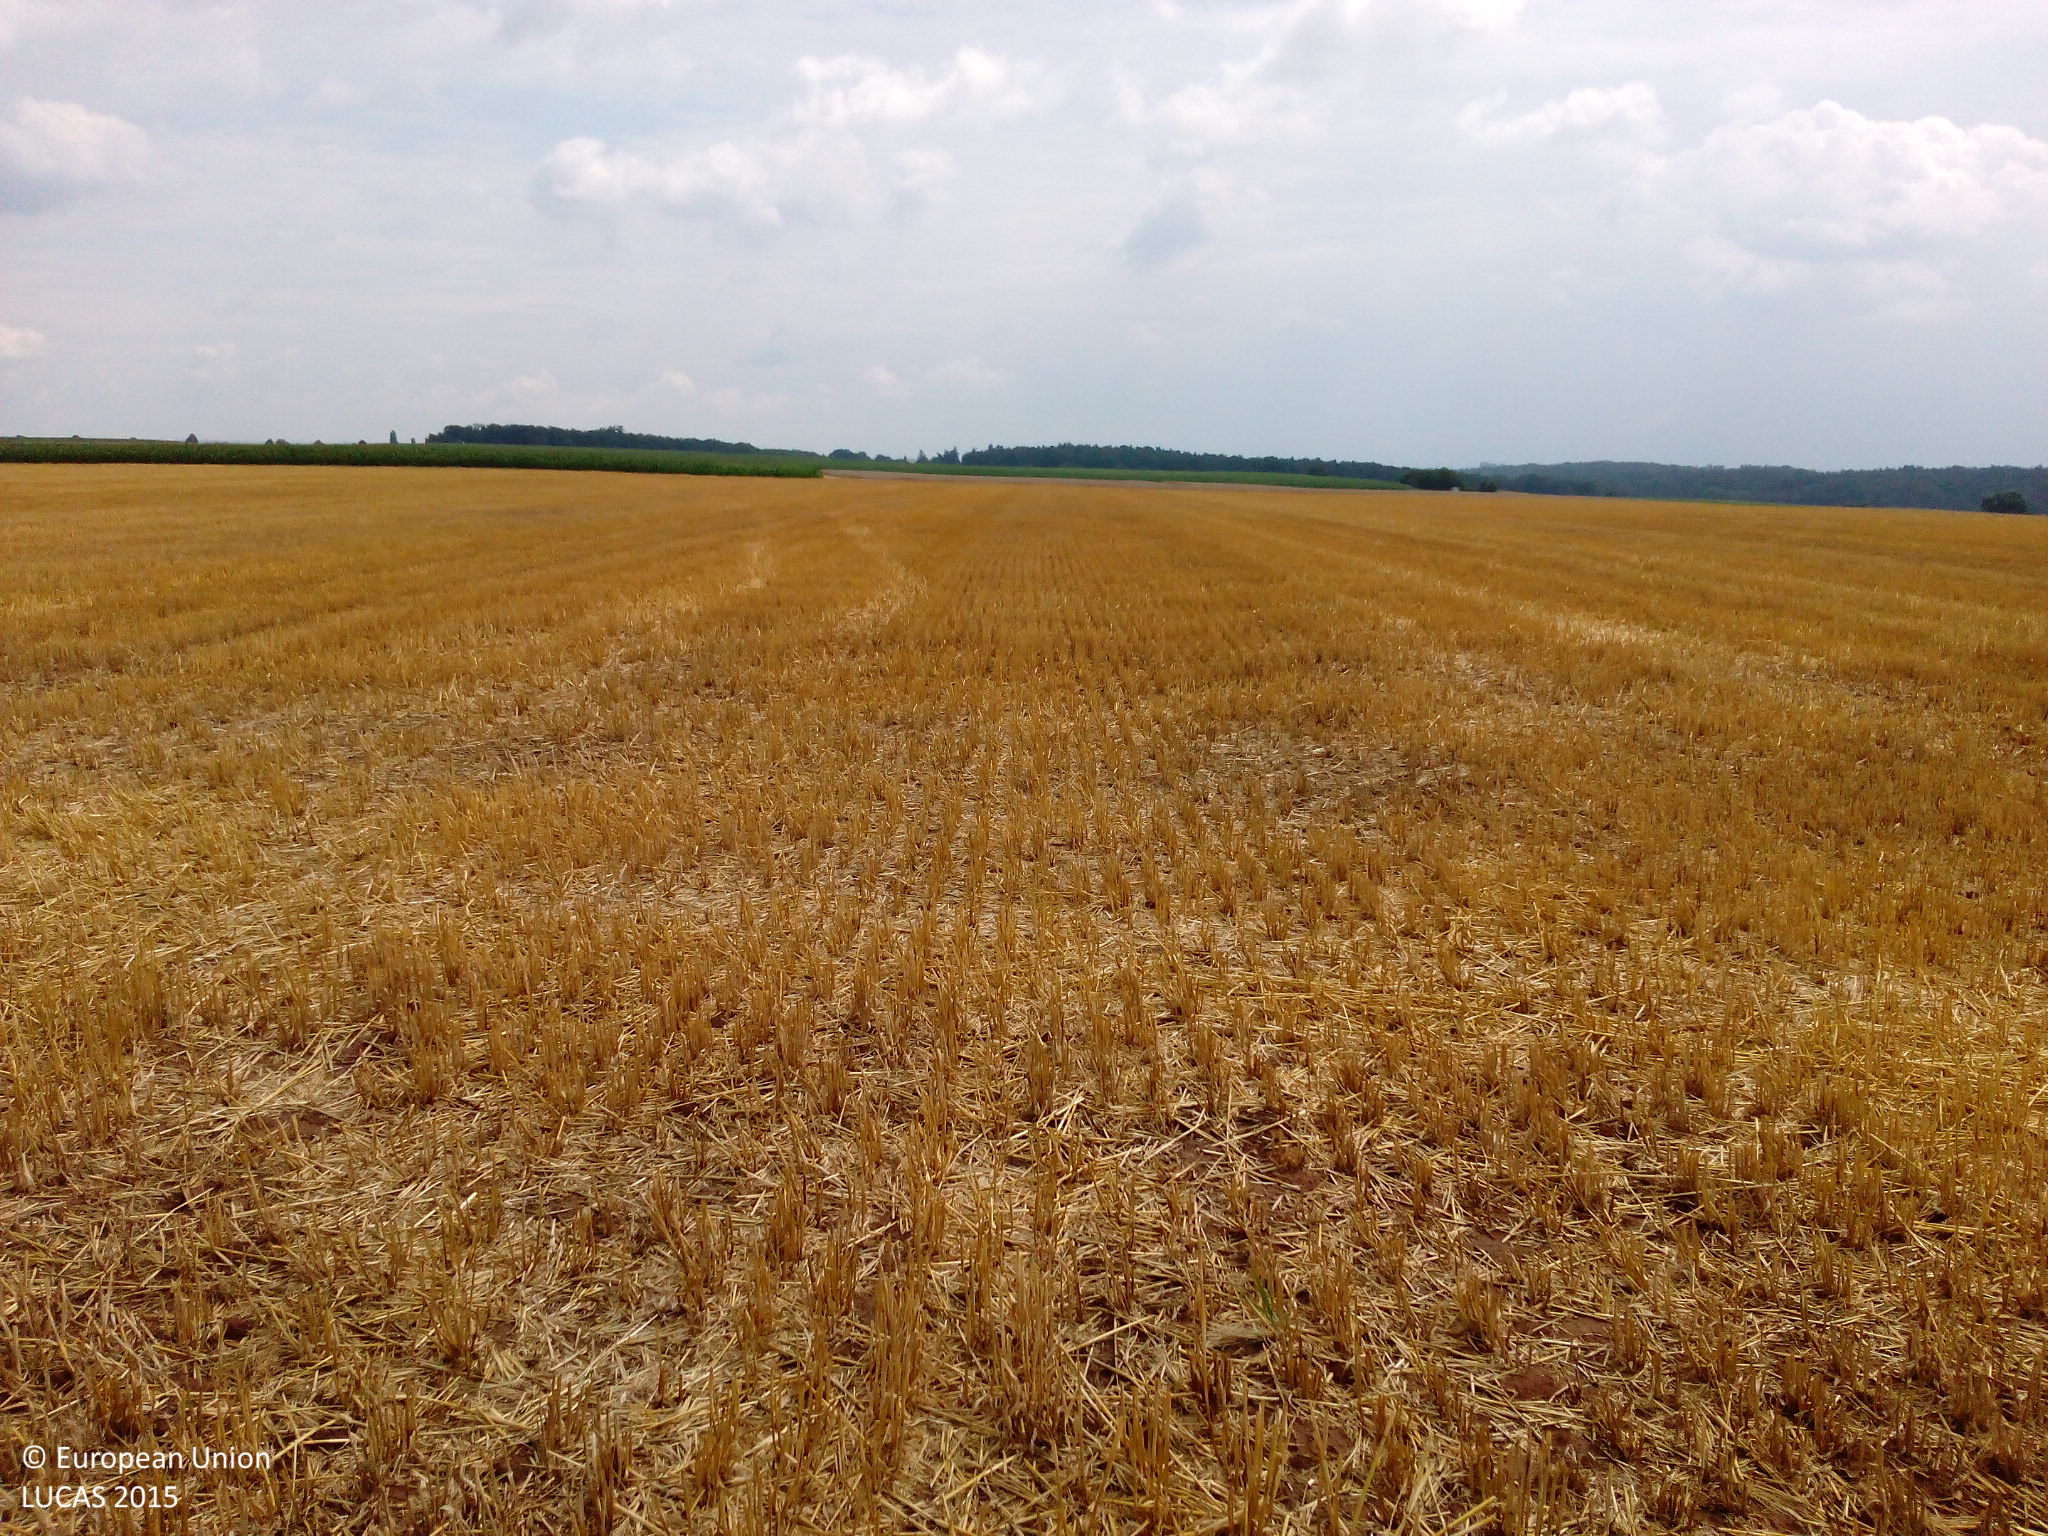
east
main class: Cropland
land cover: Barley
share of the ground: 25 - 50 %
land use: Agriculture (excluding fallow land and kitchen gardens)
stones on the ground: < 10 %
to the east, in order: Barley; Tracks; Maize
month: July
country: DE
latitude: 49.5153
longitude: 10.8975
